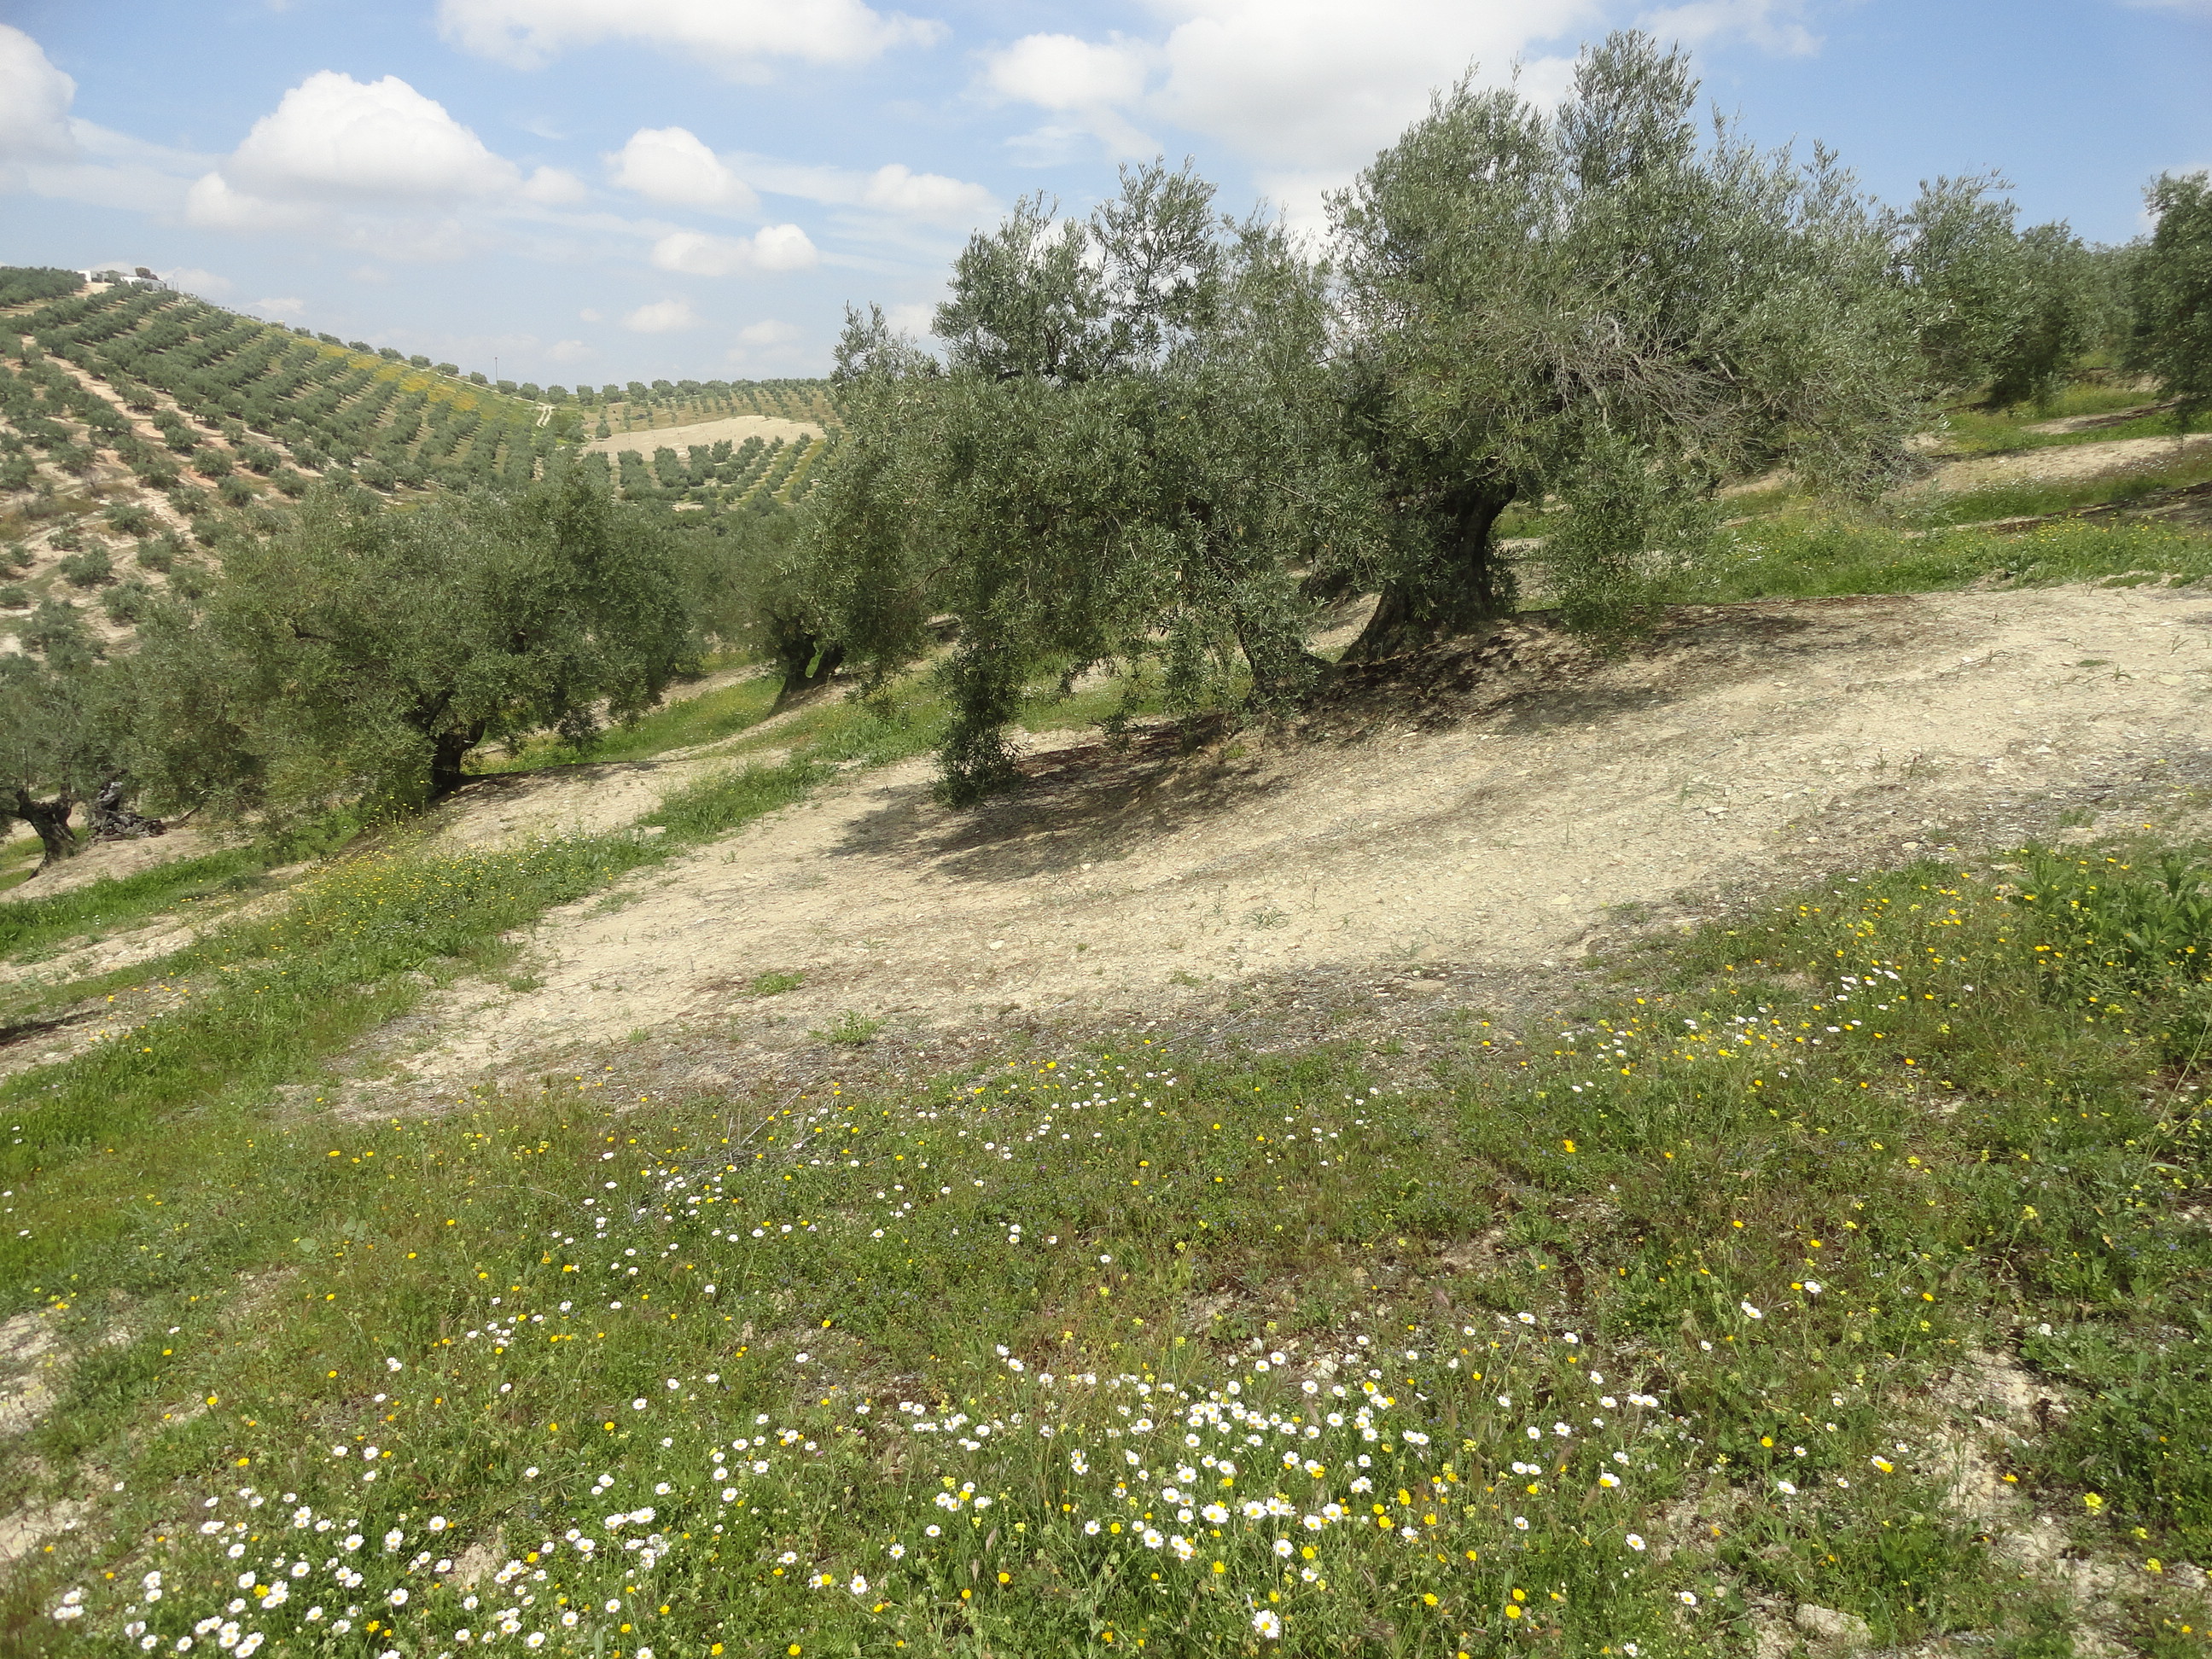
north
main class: Cropland
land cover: Olive groves
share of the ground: 50 - 75 %
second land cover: Spontaneously vegetated surfaces
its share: 10 - 25 %
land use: Agriculture (excluding fallow land and kitchen gardens)
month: April
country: ES
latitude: 37.5628
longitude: -4.5306
